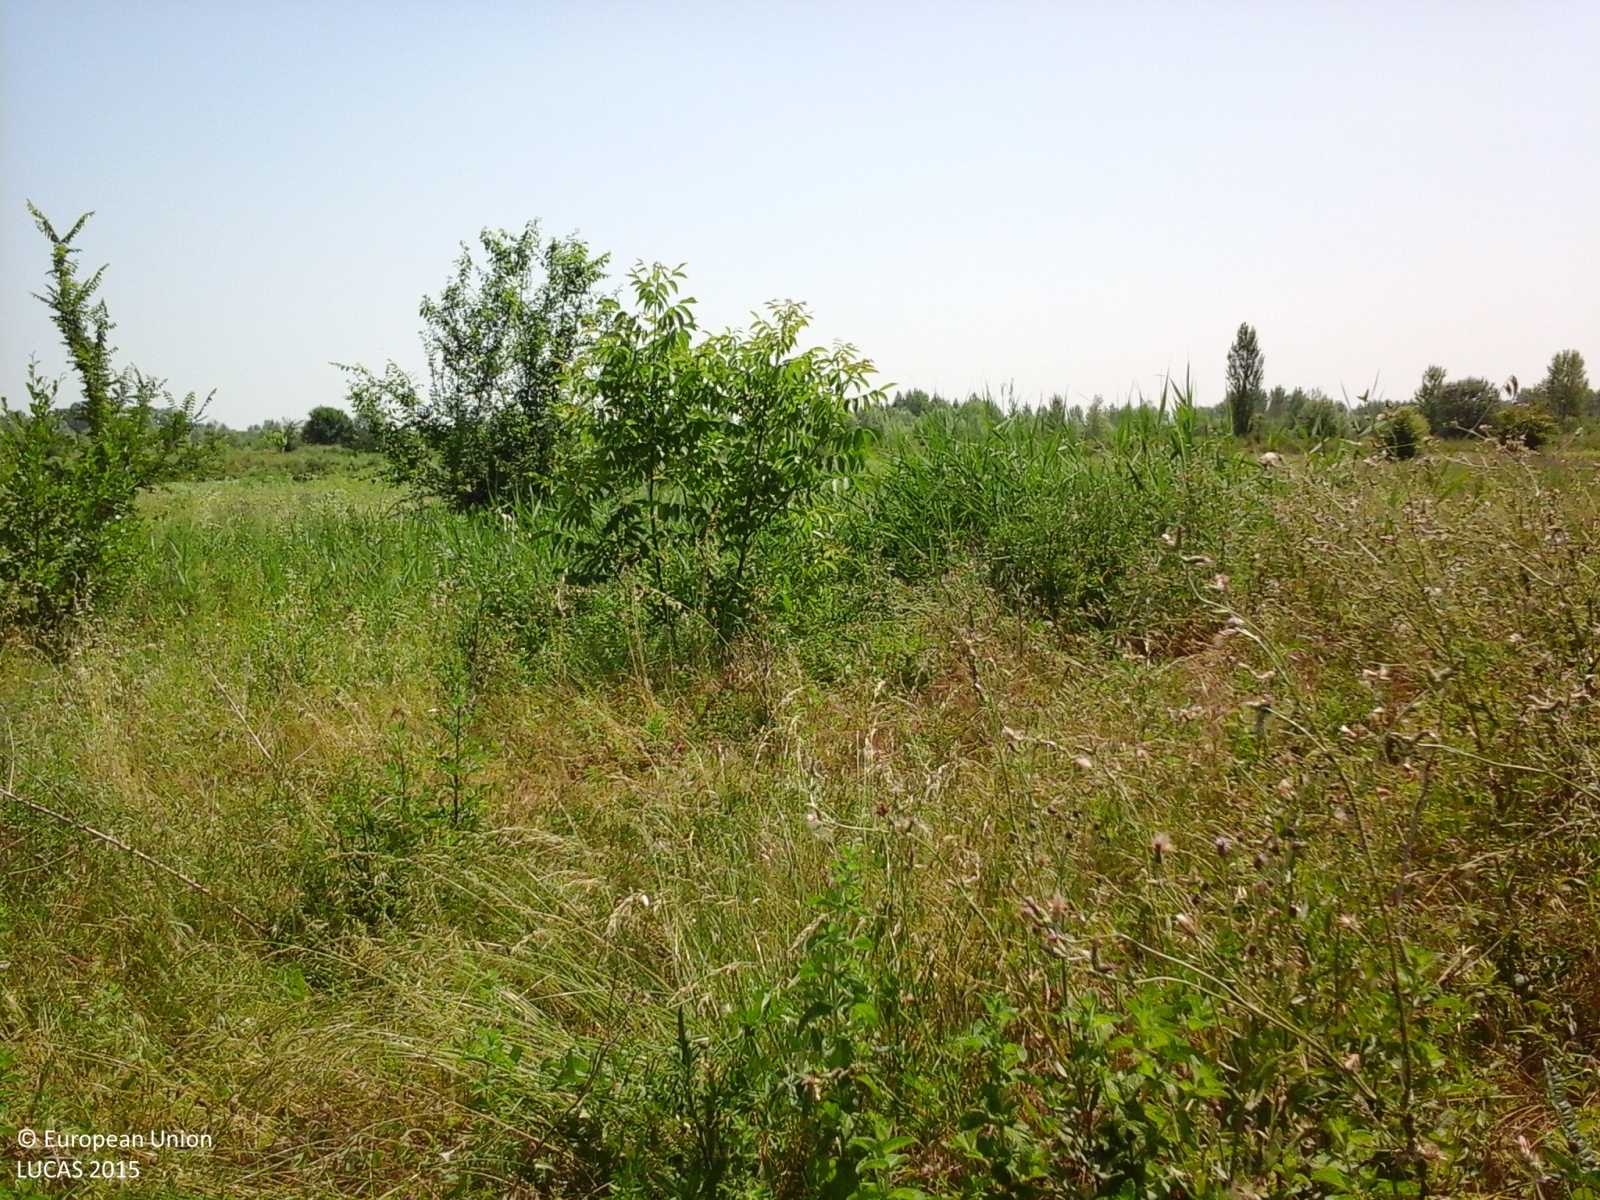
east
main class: Shrubland
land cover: Shrubland with sparse tree cover
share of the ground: > 75 %
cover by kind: shrubs 60 %, herbaceous plants 35 %, broadleaved forest trees 5 %
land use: Semi-natural and natural areas not in use
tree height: < 5 m
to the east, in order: Shrubland with sparse tree cover; Inland marshes; Shrubland with sparse tree cover; Managed hedges; Shrubland with sparse tree cover
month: June
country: IT
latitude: 44.5962
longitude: 11.1942
